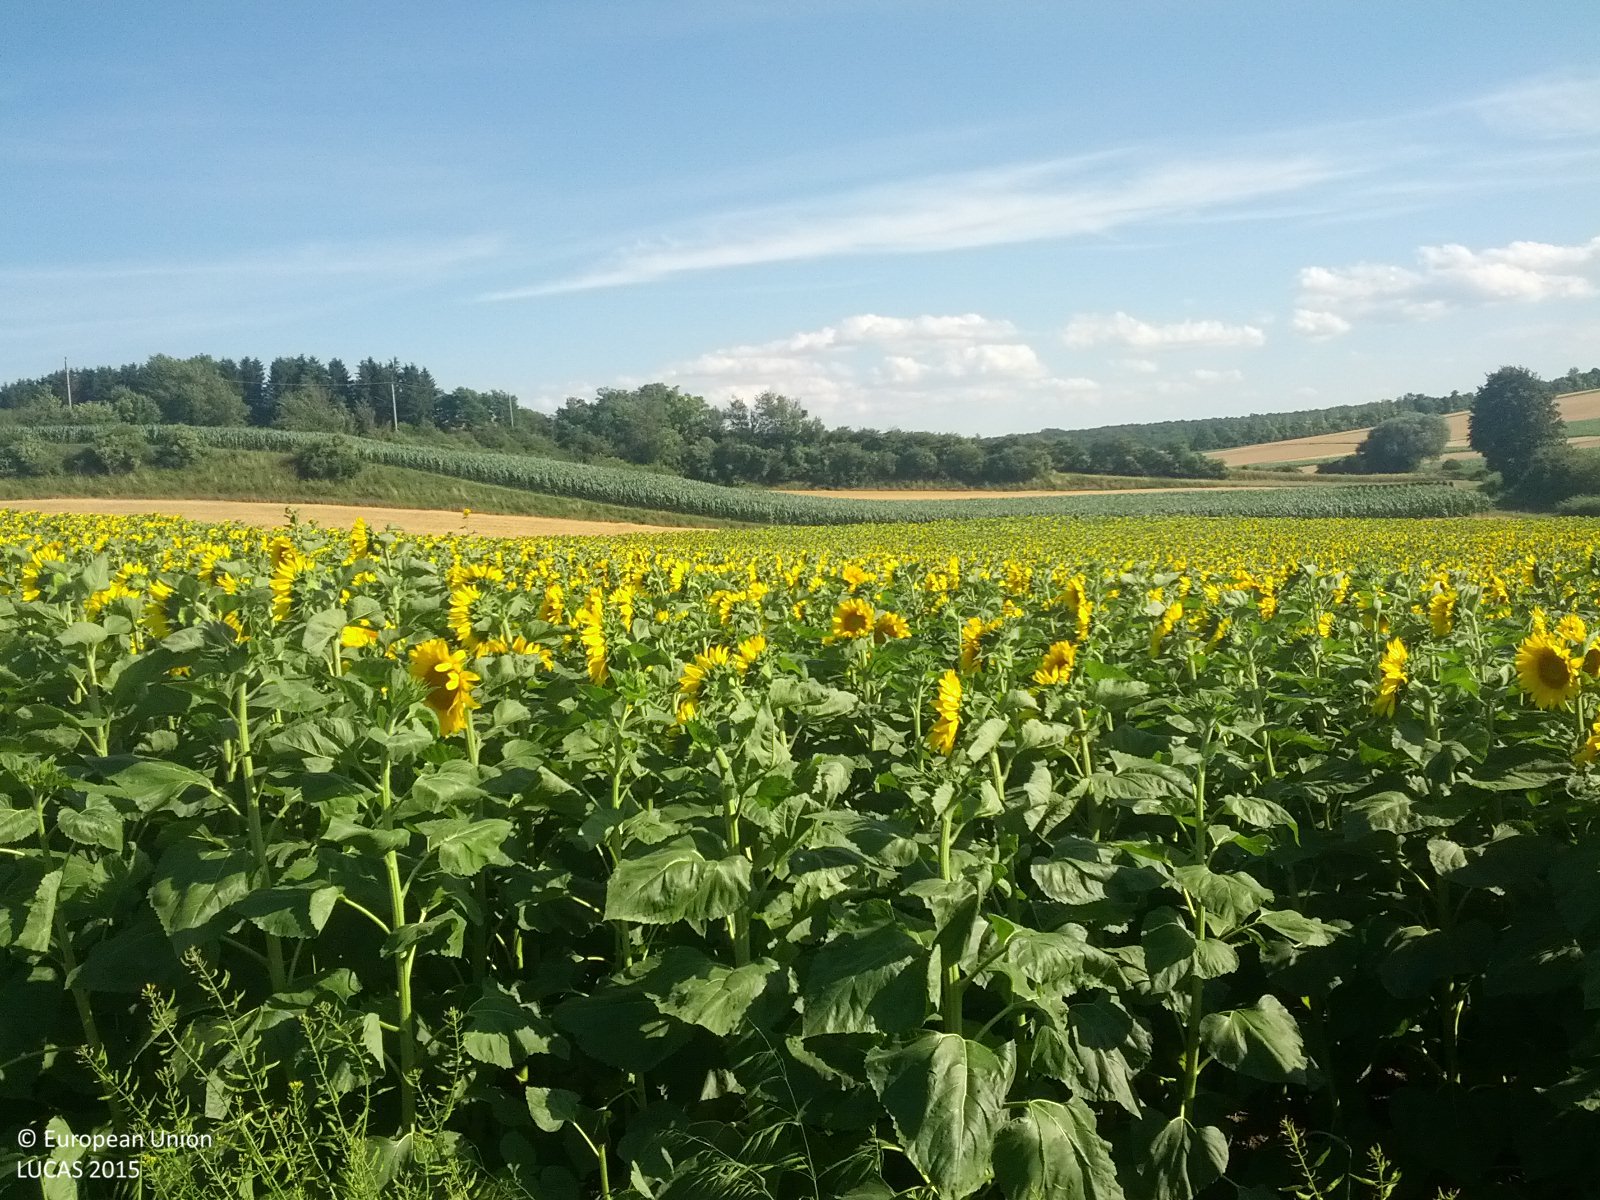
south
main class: Cropland
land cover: Other fibre and oleaginous crops
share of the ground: > 75 %
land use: Agriculture (excluding fallow land and kitchen gardens)
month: July
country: AT
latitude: 48.5196
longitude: 16.4912
